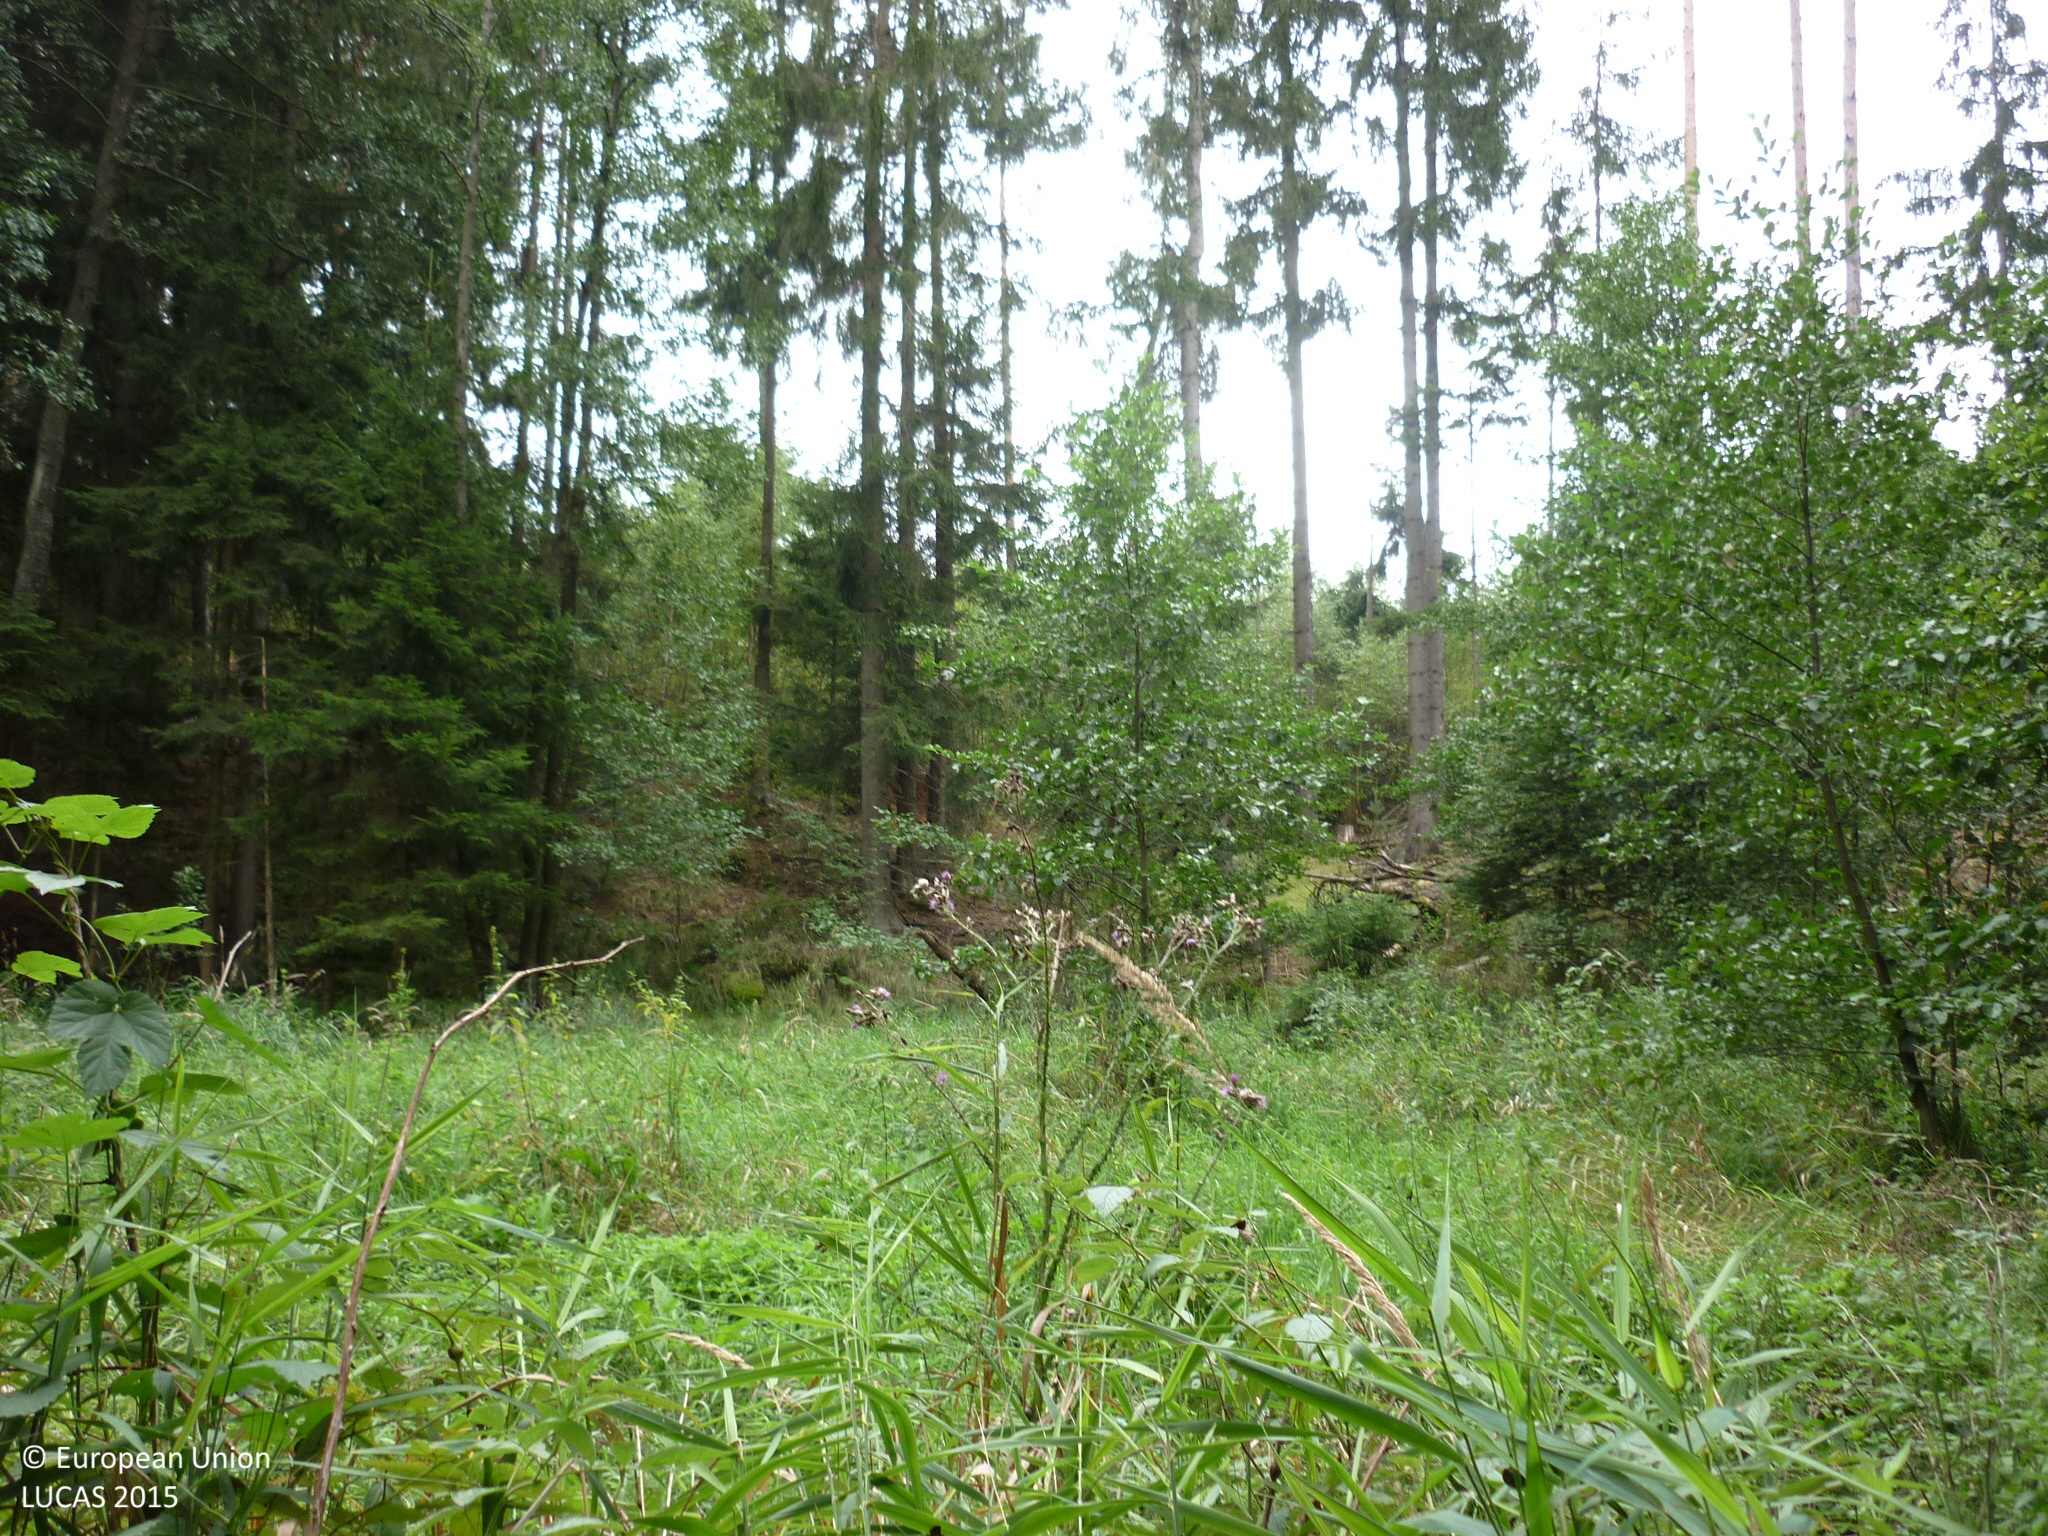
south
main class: Woodland
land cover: Spruce dominated coniferous woodland
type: hemiboreal forest and nemoral coniferous forest and mixed broadleaved-coniferous forest
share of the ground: 50 - 75 %
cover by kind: coniferous forest trees 65 %, herbaceous plants 20 %, shrubs 10 %, broadleaved forest trees 5 %
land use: Forestry
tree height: > 5 m
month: September
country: AT
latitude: 48.7736
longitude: 15.0775
